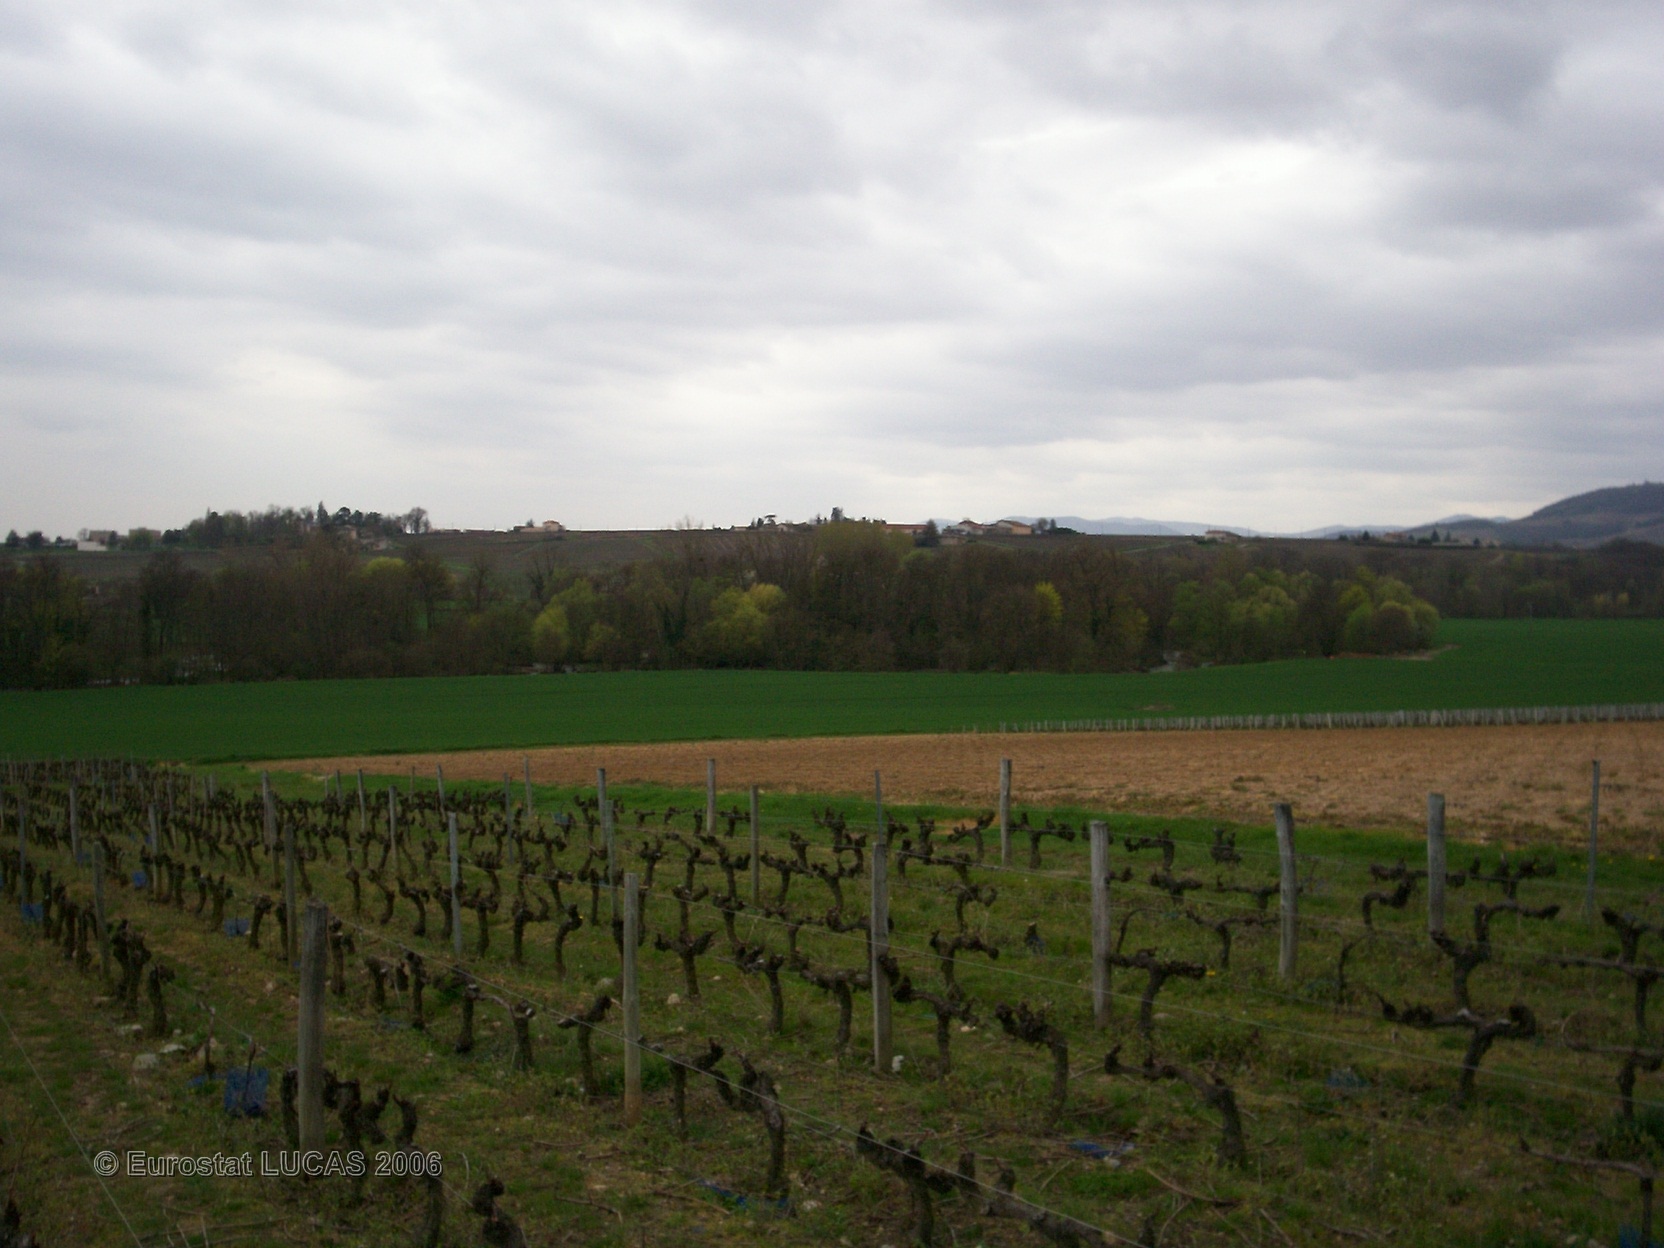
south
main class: Cropland
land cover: Vineyards
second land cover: Grassland without tree/shrub cover
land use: Agriculture (excluding fallow land and kitchen gardens)
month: April
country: FR
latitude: 46.1300
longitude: 4.7089
